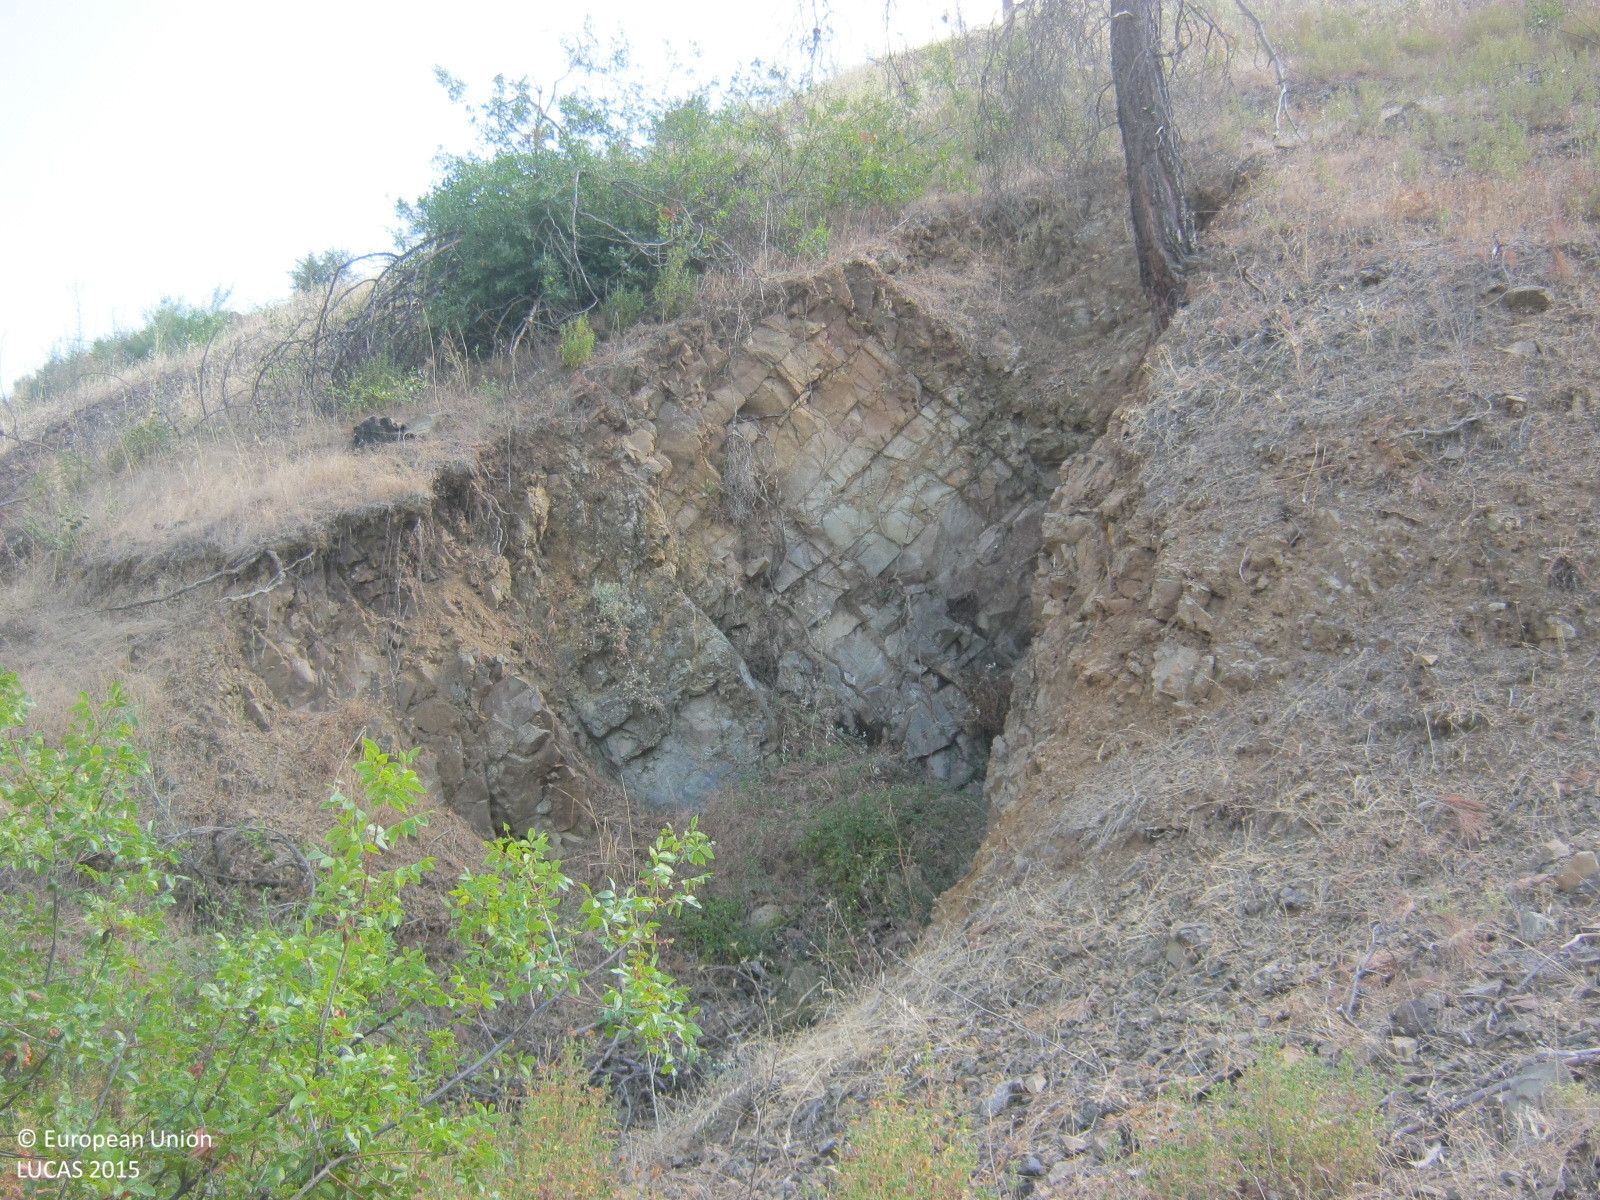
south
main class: Cropland
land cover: Olive groves
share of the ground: 25 - 50 %
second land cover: Shrubland without tree cover
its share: > 75 %
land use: Abandoned areas
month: June
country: CY
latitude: 34.9860
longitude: 33.1290
